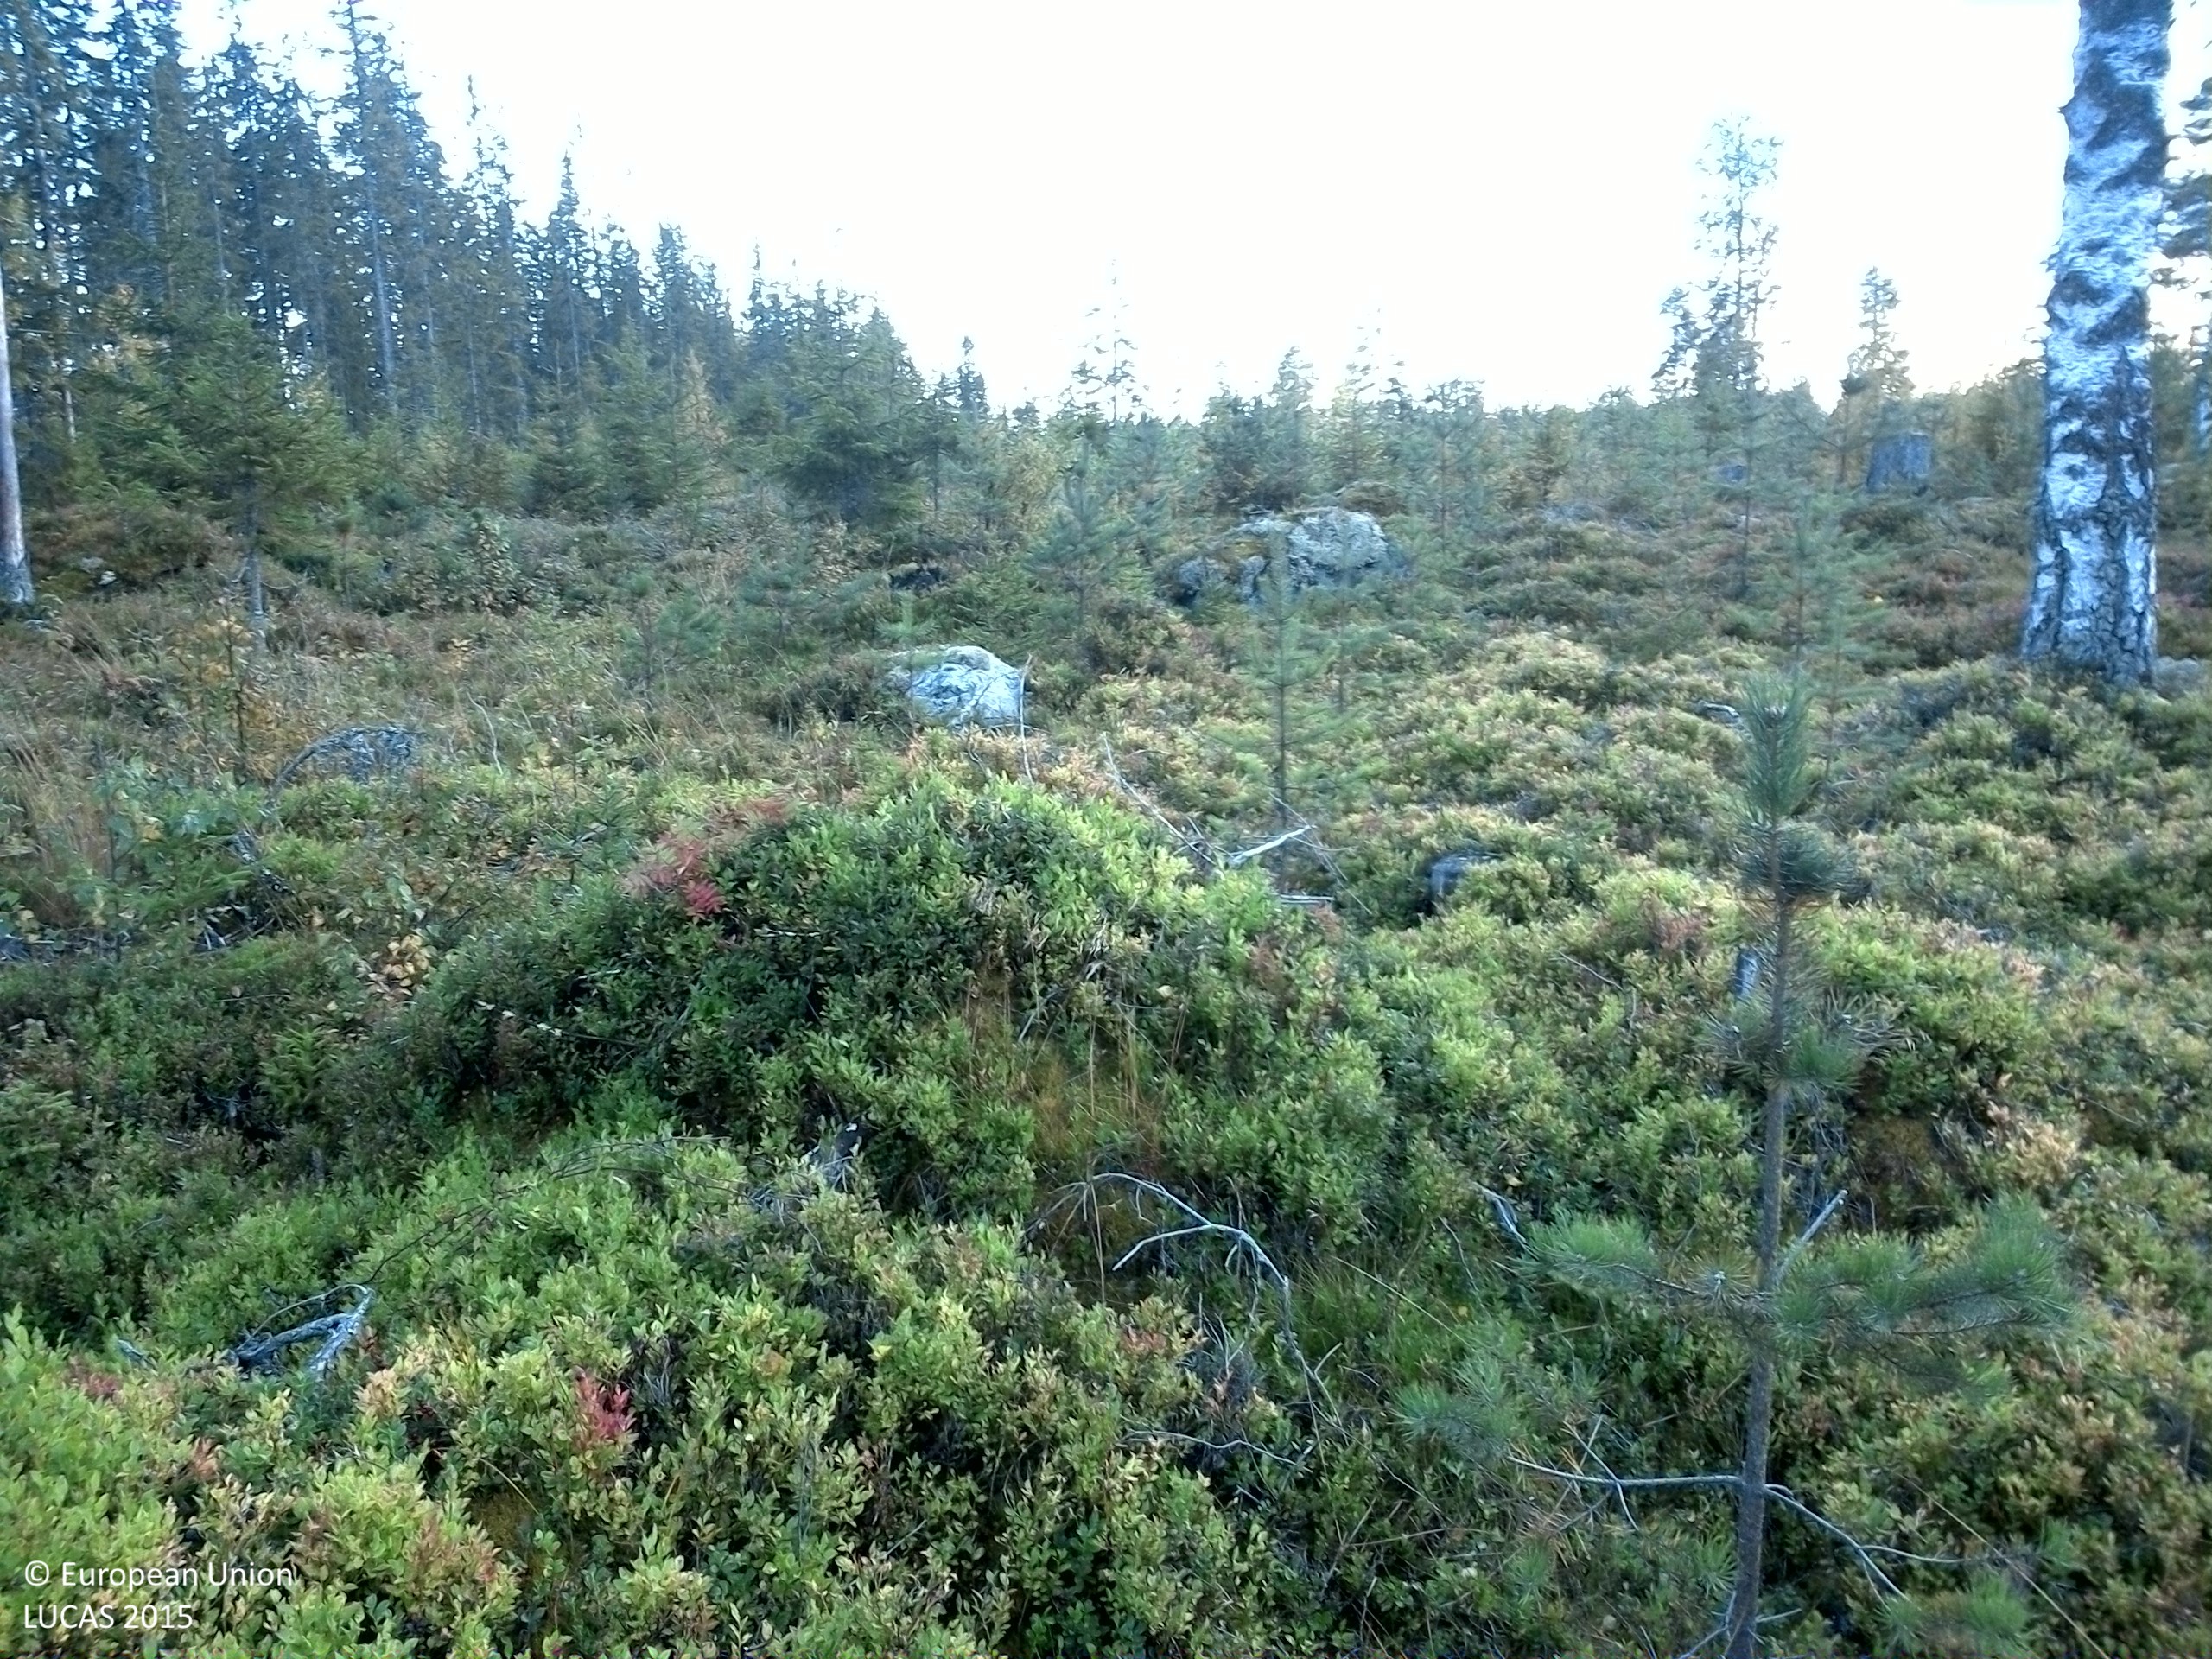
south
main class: Woodland
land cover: Other coniferous woodland
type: boreal forest
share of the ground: 10 - 25 %
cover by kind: shrubs 50 %, coniferous forest trees 25 %, lichens and mosses 20 %, herbaceous plants 5 %
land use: Forestry
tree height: < 5 m
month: September
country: SE
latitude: 61.3982
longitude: 15.3212
